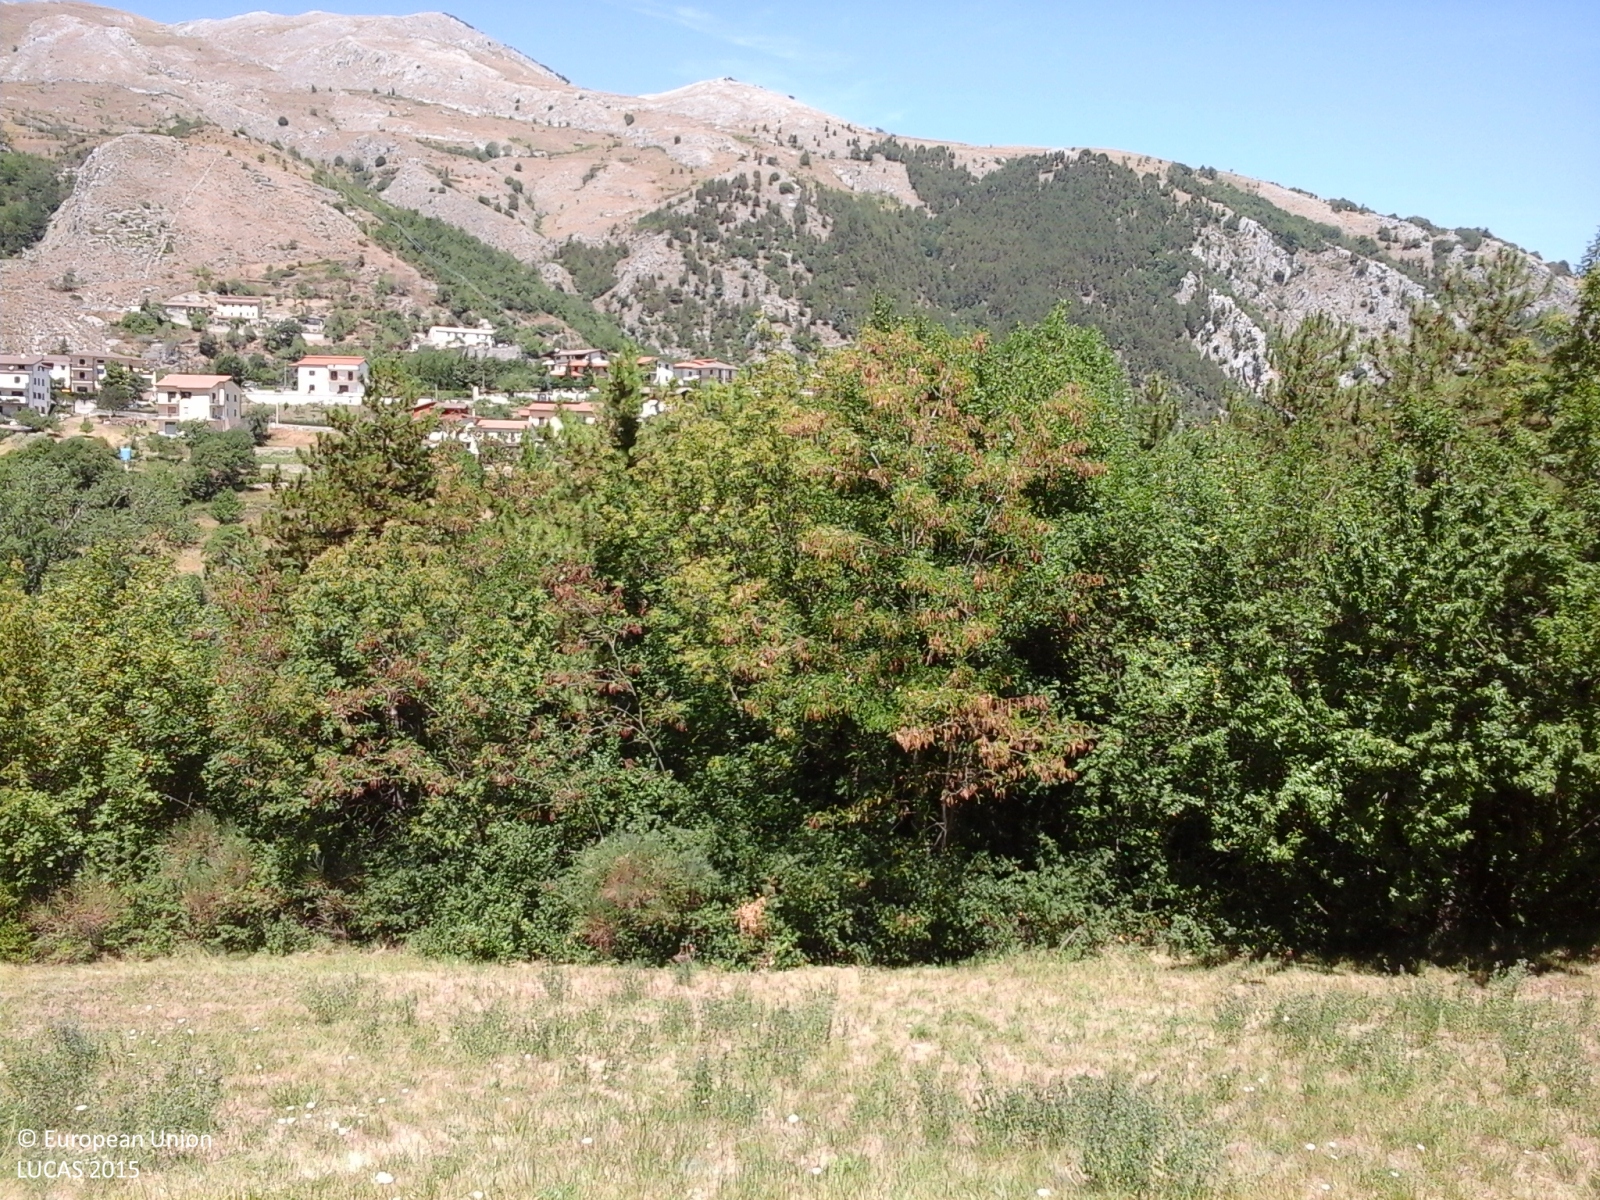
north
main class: Grassland
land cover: Grassland without tree/shrub cover
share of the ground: > 75 %
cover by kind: herbaceous plants 100 %
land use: Agriculture (excluding fallow land and kitchen gardens)
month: July
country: IT
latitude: 41.4928
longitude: 14.3562
